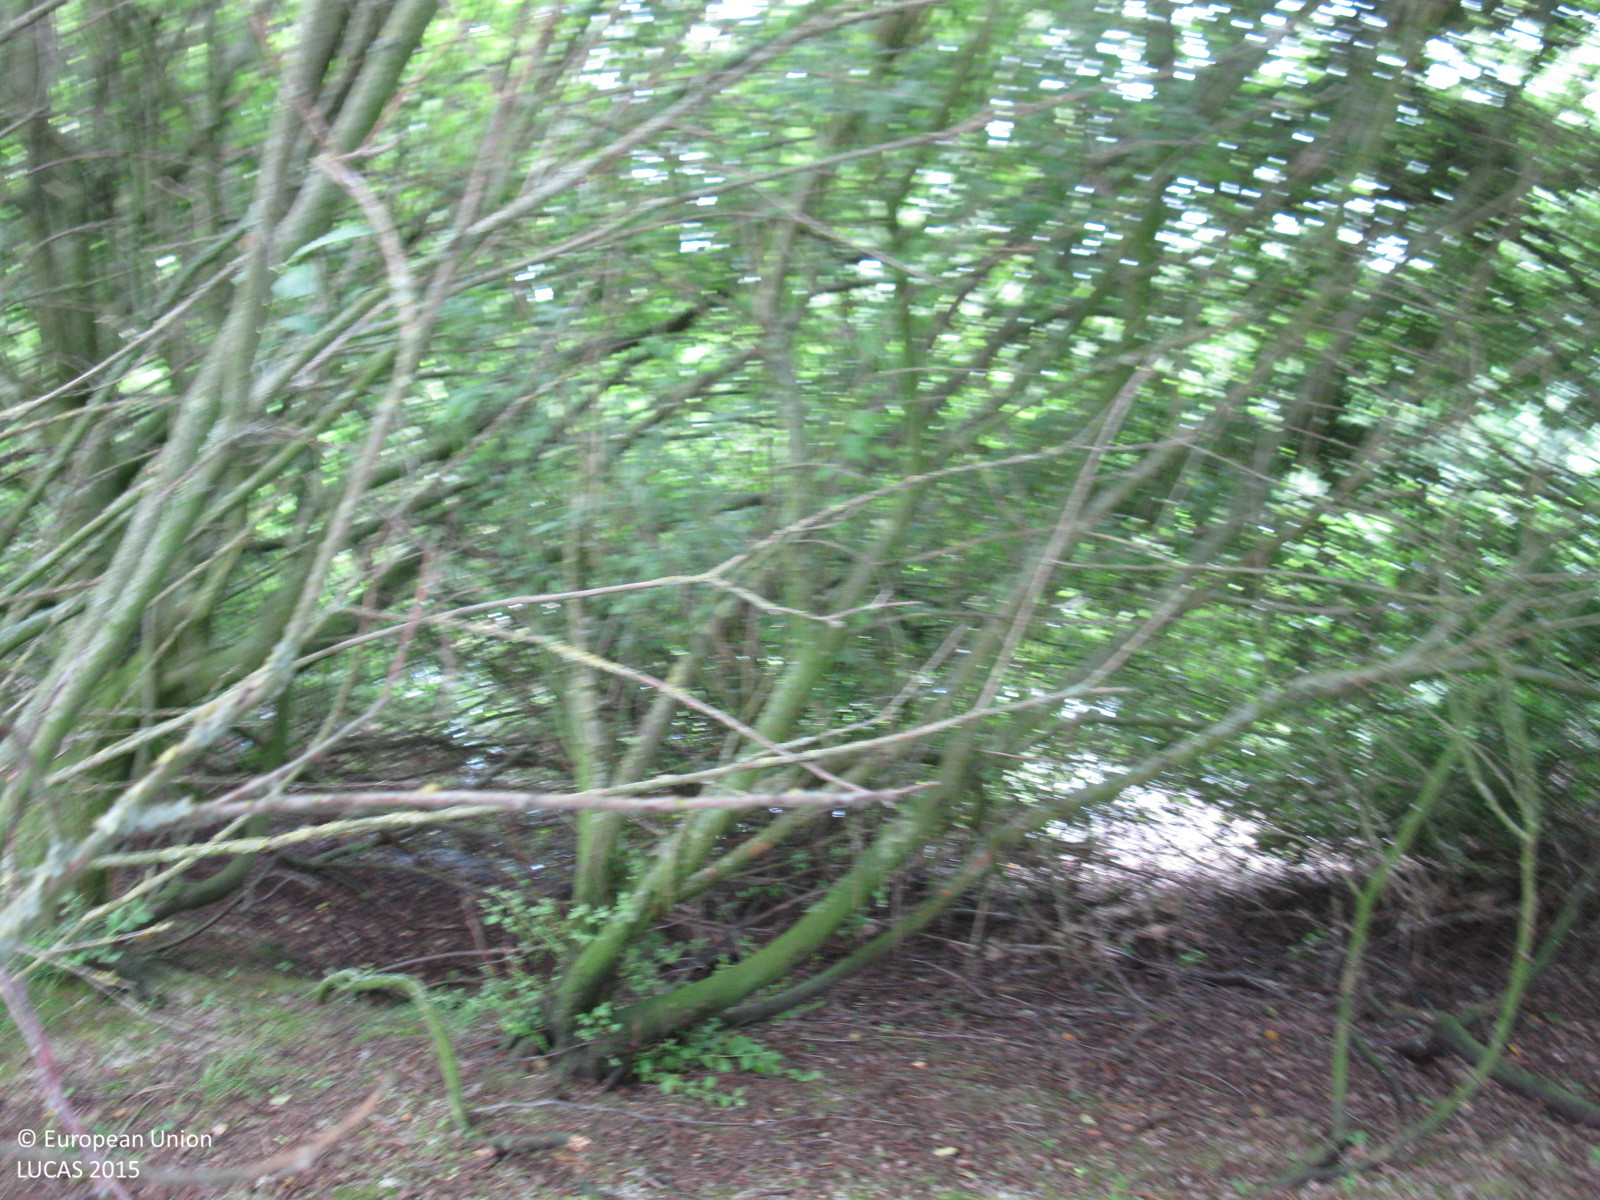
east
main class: Woodland
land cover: Broadleaved woodland
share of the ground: > 75 %
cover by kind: broadleaved forest trees 100 %
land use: Semi-natural and natural areas not in use
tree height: > 5 m
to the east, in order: Broadleaved woodland; Inland fresh water bodies; Broadleaved woodland; Grassland with sparse tree/shrub cover
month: July
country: DE
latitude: 53.3475
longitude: 7.8826
